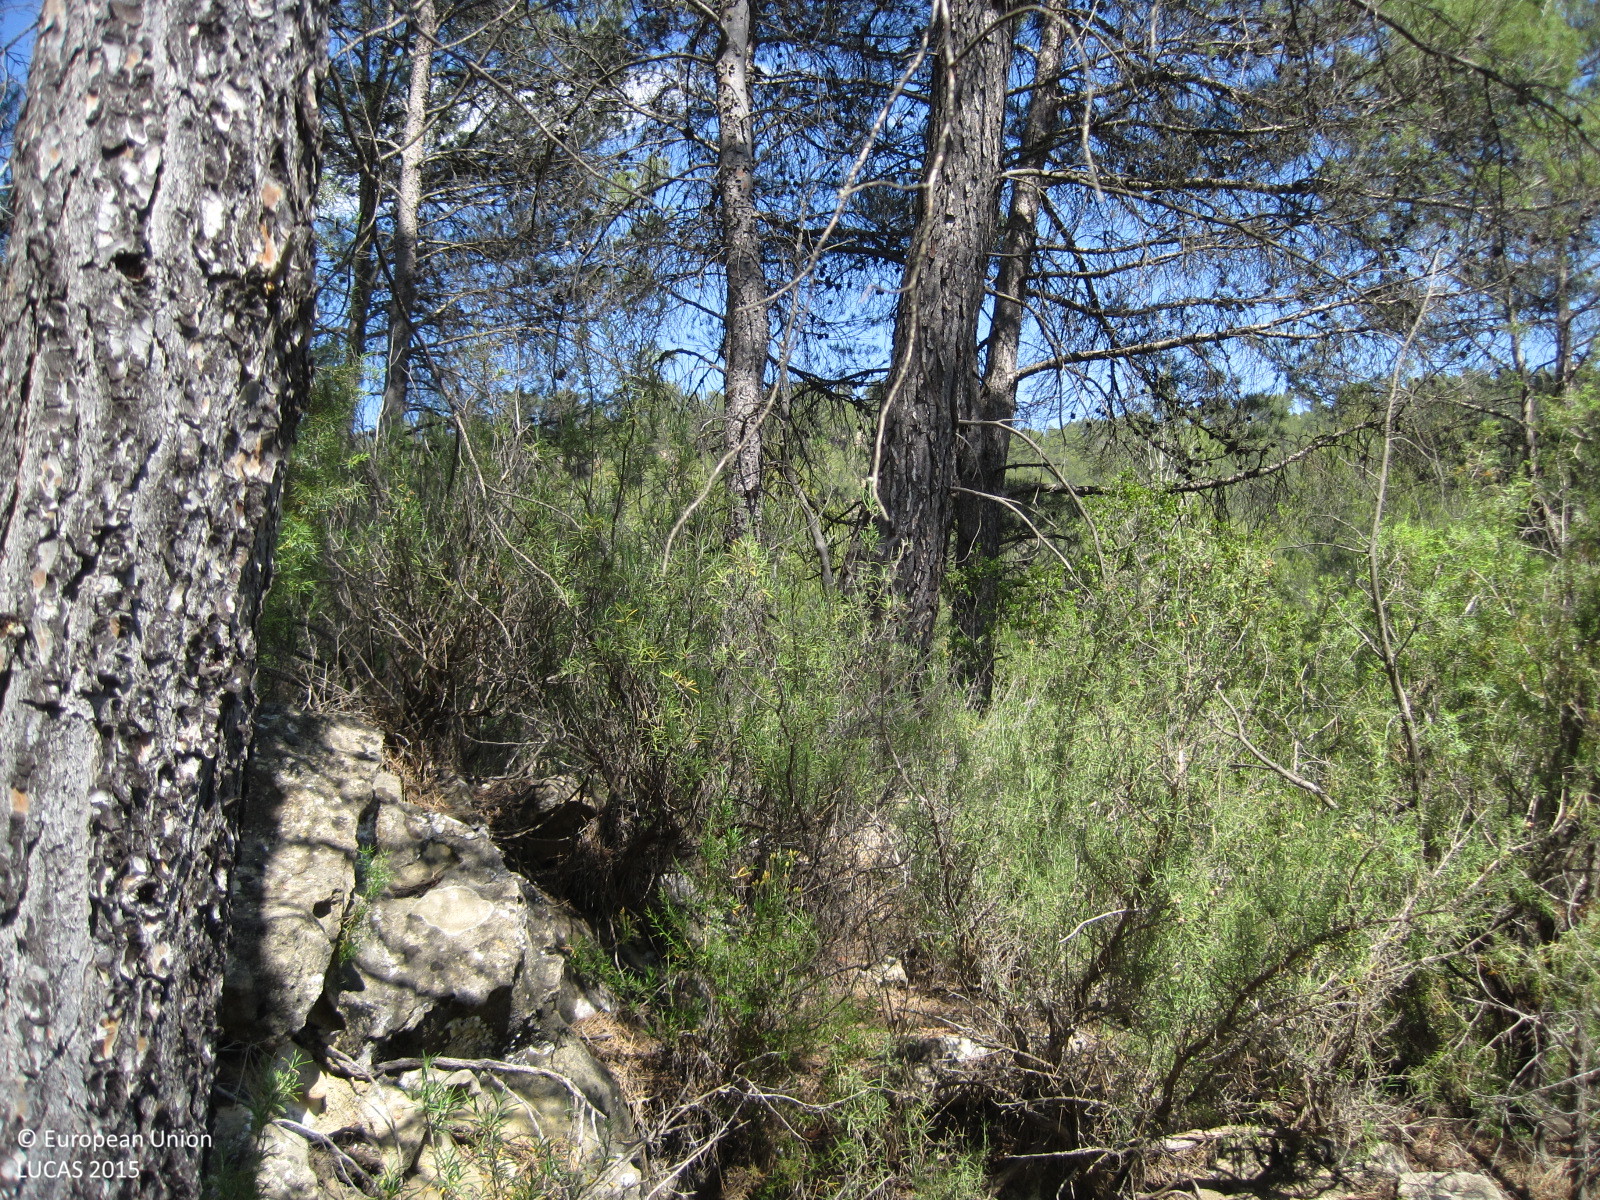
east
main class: Woodland
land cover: Pine dominated coniferous woodland
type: coniferous forest of the mediterranean region
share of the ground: 25 - 50 %
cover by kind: coniferous forest trees 40 %, shrubs 40 %, herbaceous plants 10 %, consolidated bare surface 10 %
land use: Forestry
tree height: > 5 m
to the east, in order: Pine dominated coniferous woodland; Tracks; Pine dominated coniferous woodland; Grassland with sparse tree/shrub cover; Pine dominated coniferous woodland; Dry stone walls; Pine dominated coniferous woodland; Tracks; Spontaneously vegetated surfaces; Ditches and canals; Spontaneously vegetated surfaces; Pine dominated coniferous woodland
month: June
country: ES
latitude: 39.7036
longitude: -1.1421
